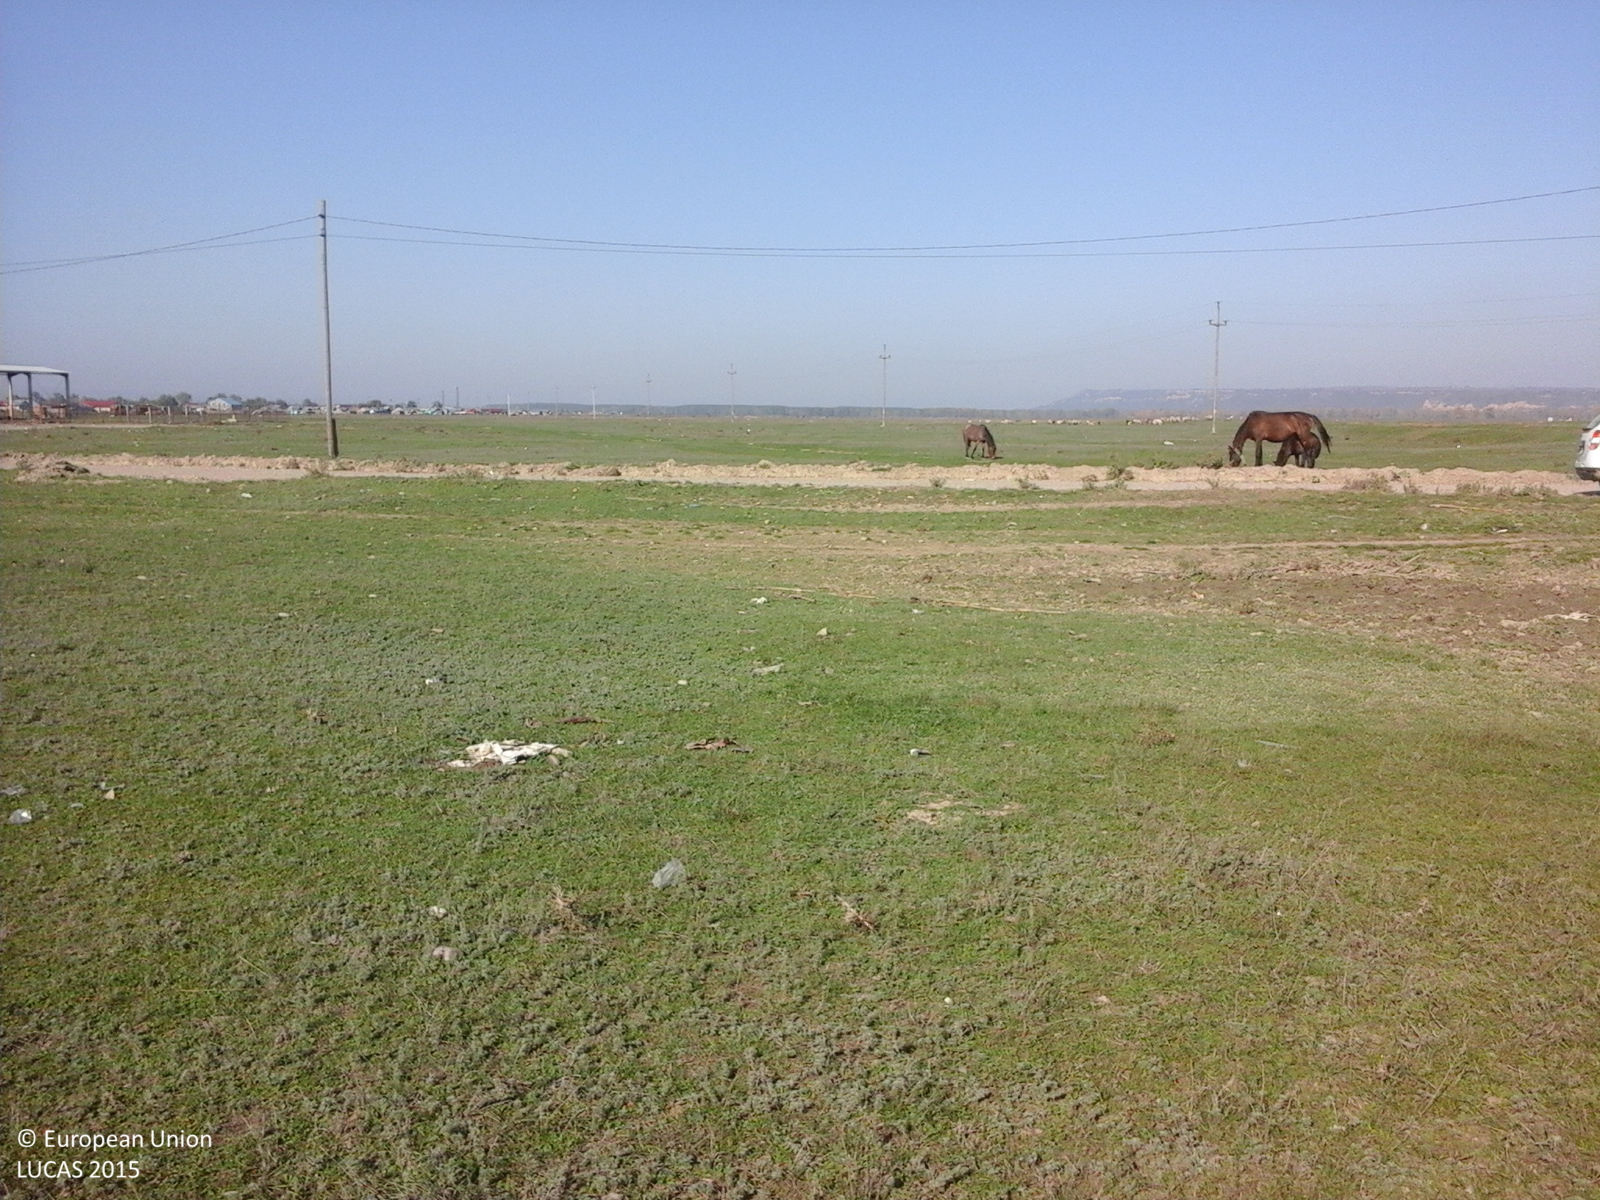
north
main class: Grassland
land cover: Grassland without tree/shrub cover
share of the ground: > 75 %
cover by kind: herbaceous plants 100 %
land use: Agriculture (excluding fallow land and kitchen gardens)
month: October
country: RO
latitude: 45.8752
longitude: 27.2460
